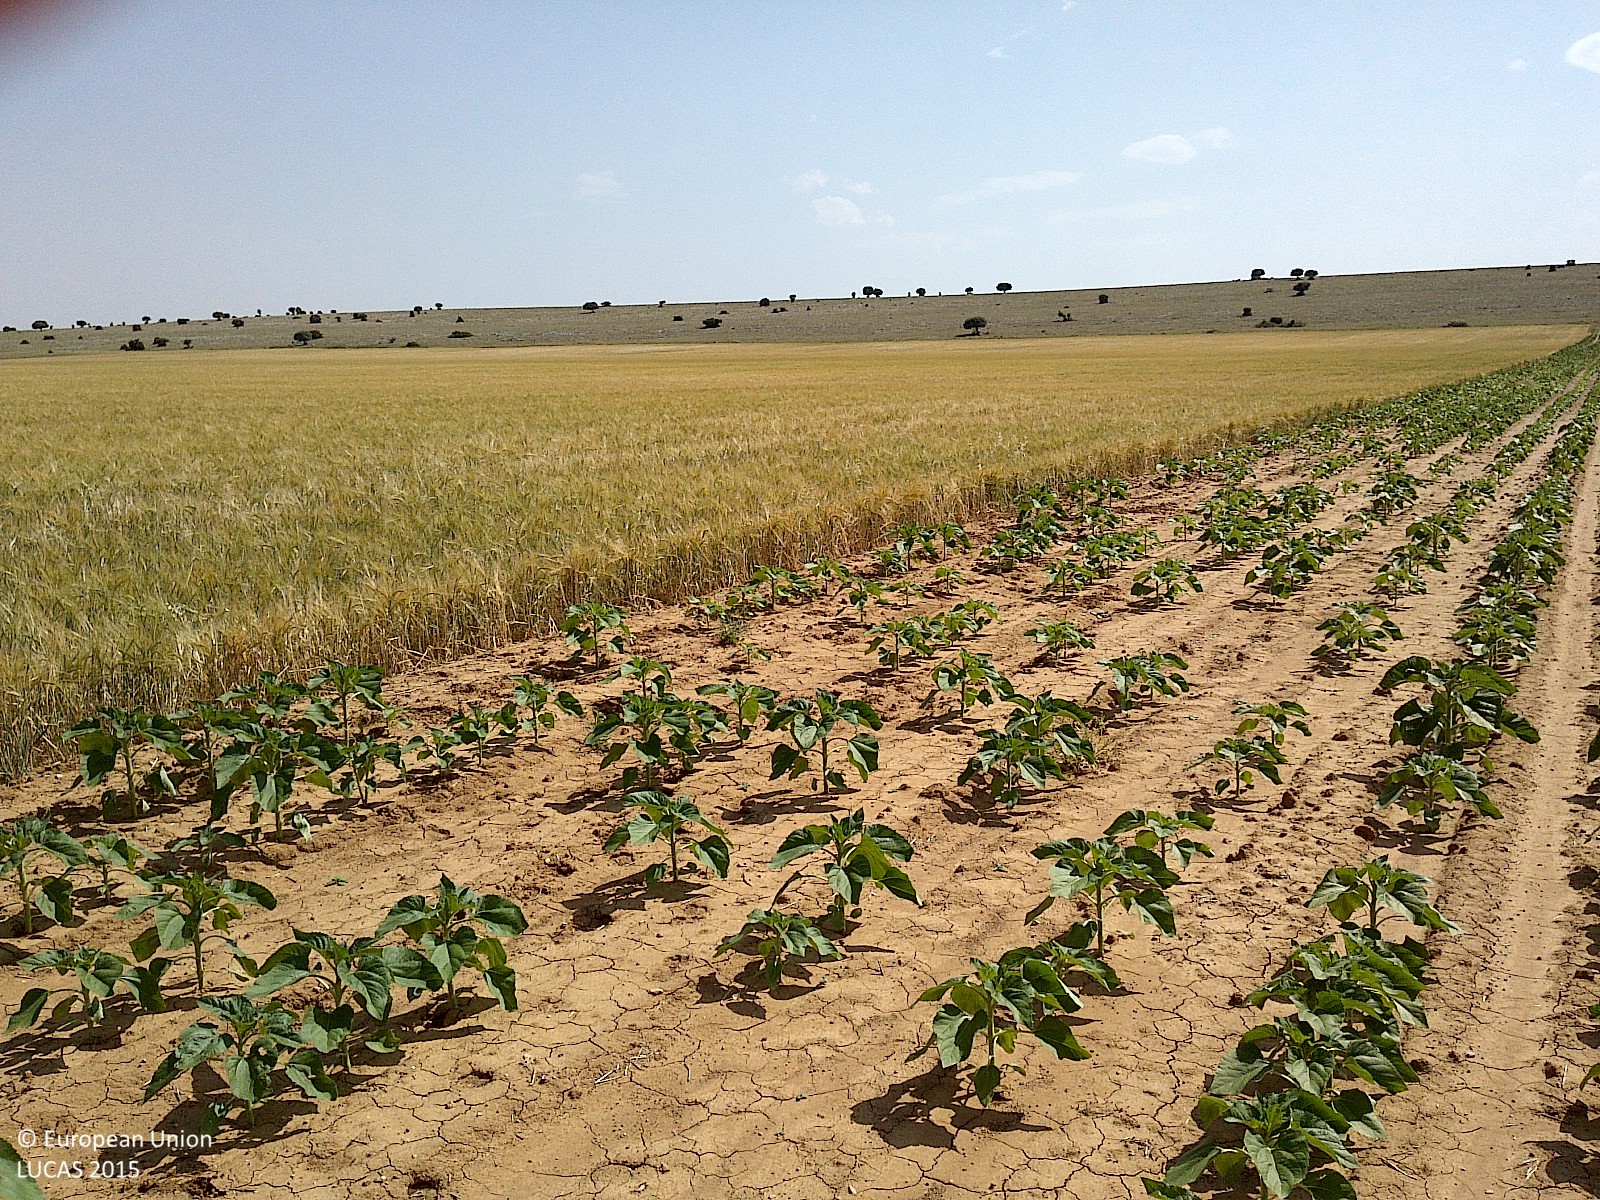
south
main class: Cropland
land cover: Sunflower
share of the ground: < 10 %
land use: Agriculture (excluding fallow land and kitchen gardens)
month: July
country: ES
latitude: 41.6135
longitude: -2.1170
